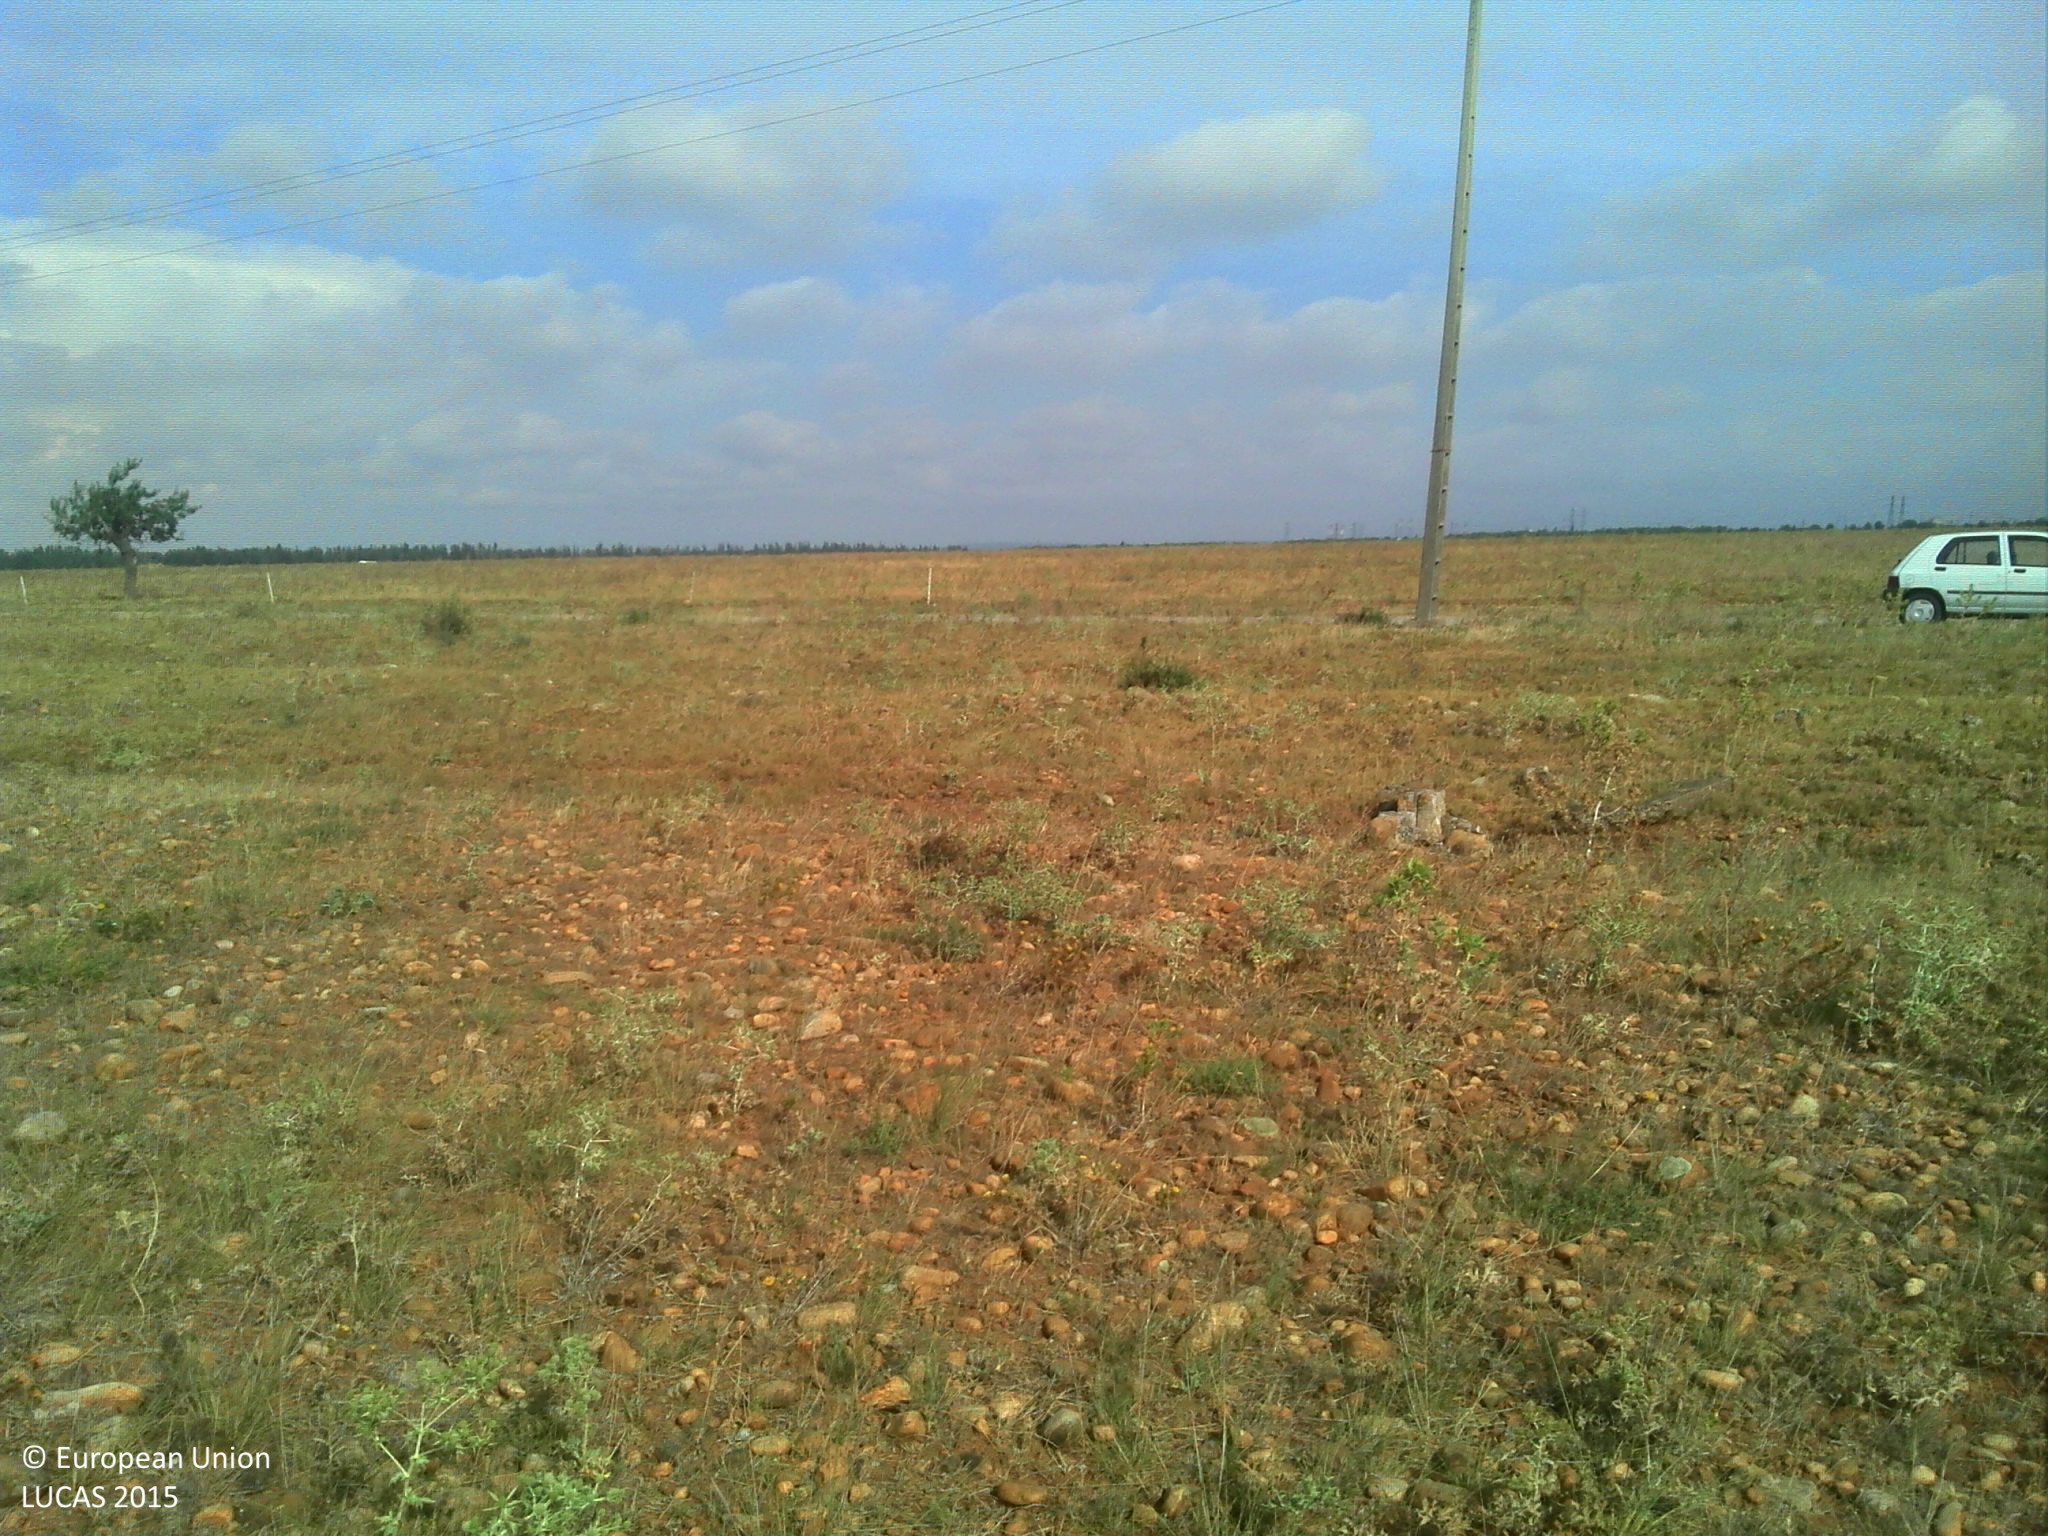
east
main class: Grassland
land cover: Spontaneously vegetated surfaces
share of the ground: 25 - 50 %
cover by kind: unconsolidated bare surface 60 %, herbaceous plants 35 %, shrubs 5 %
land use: Agriculture (excluding fallow land and kitchen gardens)
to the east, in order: Spontaneously vegetated surfaces; Electric lines; Tracks; Grass margins; Fences; Shrubland without tree cover
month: July
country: FR
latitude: 43.4998
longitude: 4.8528
